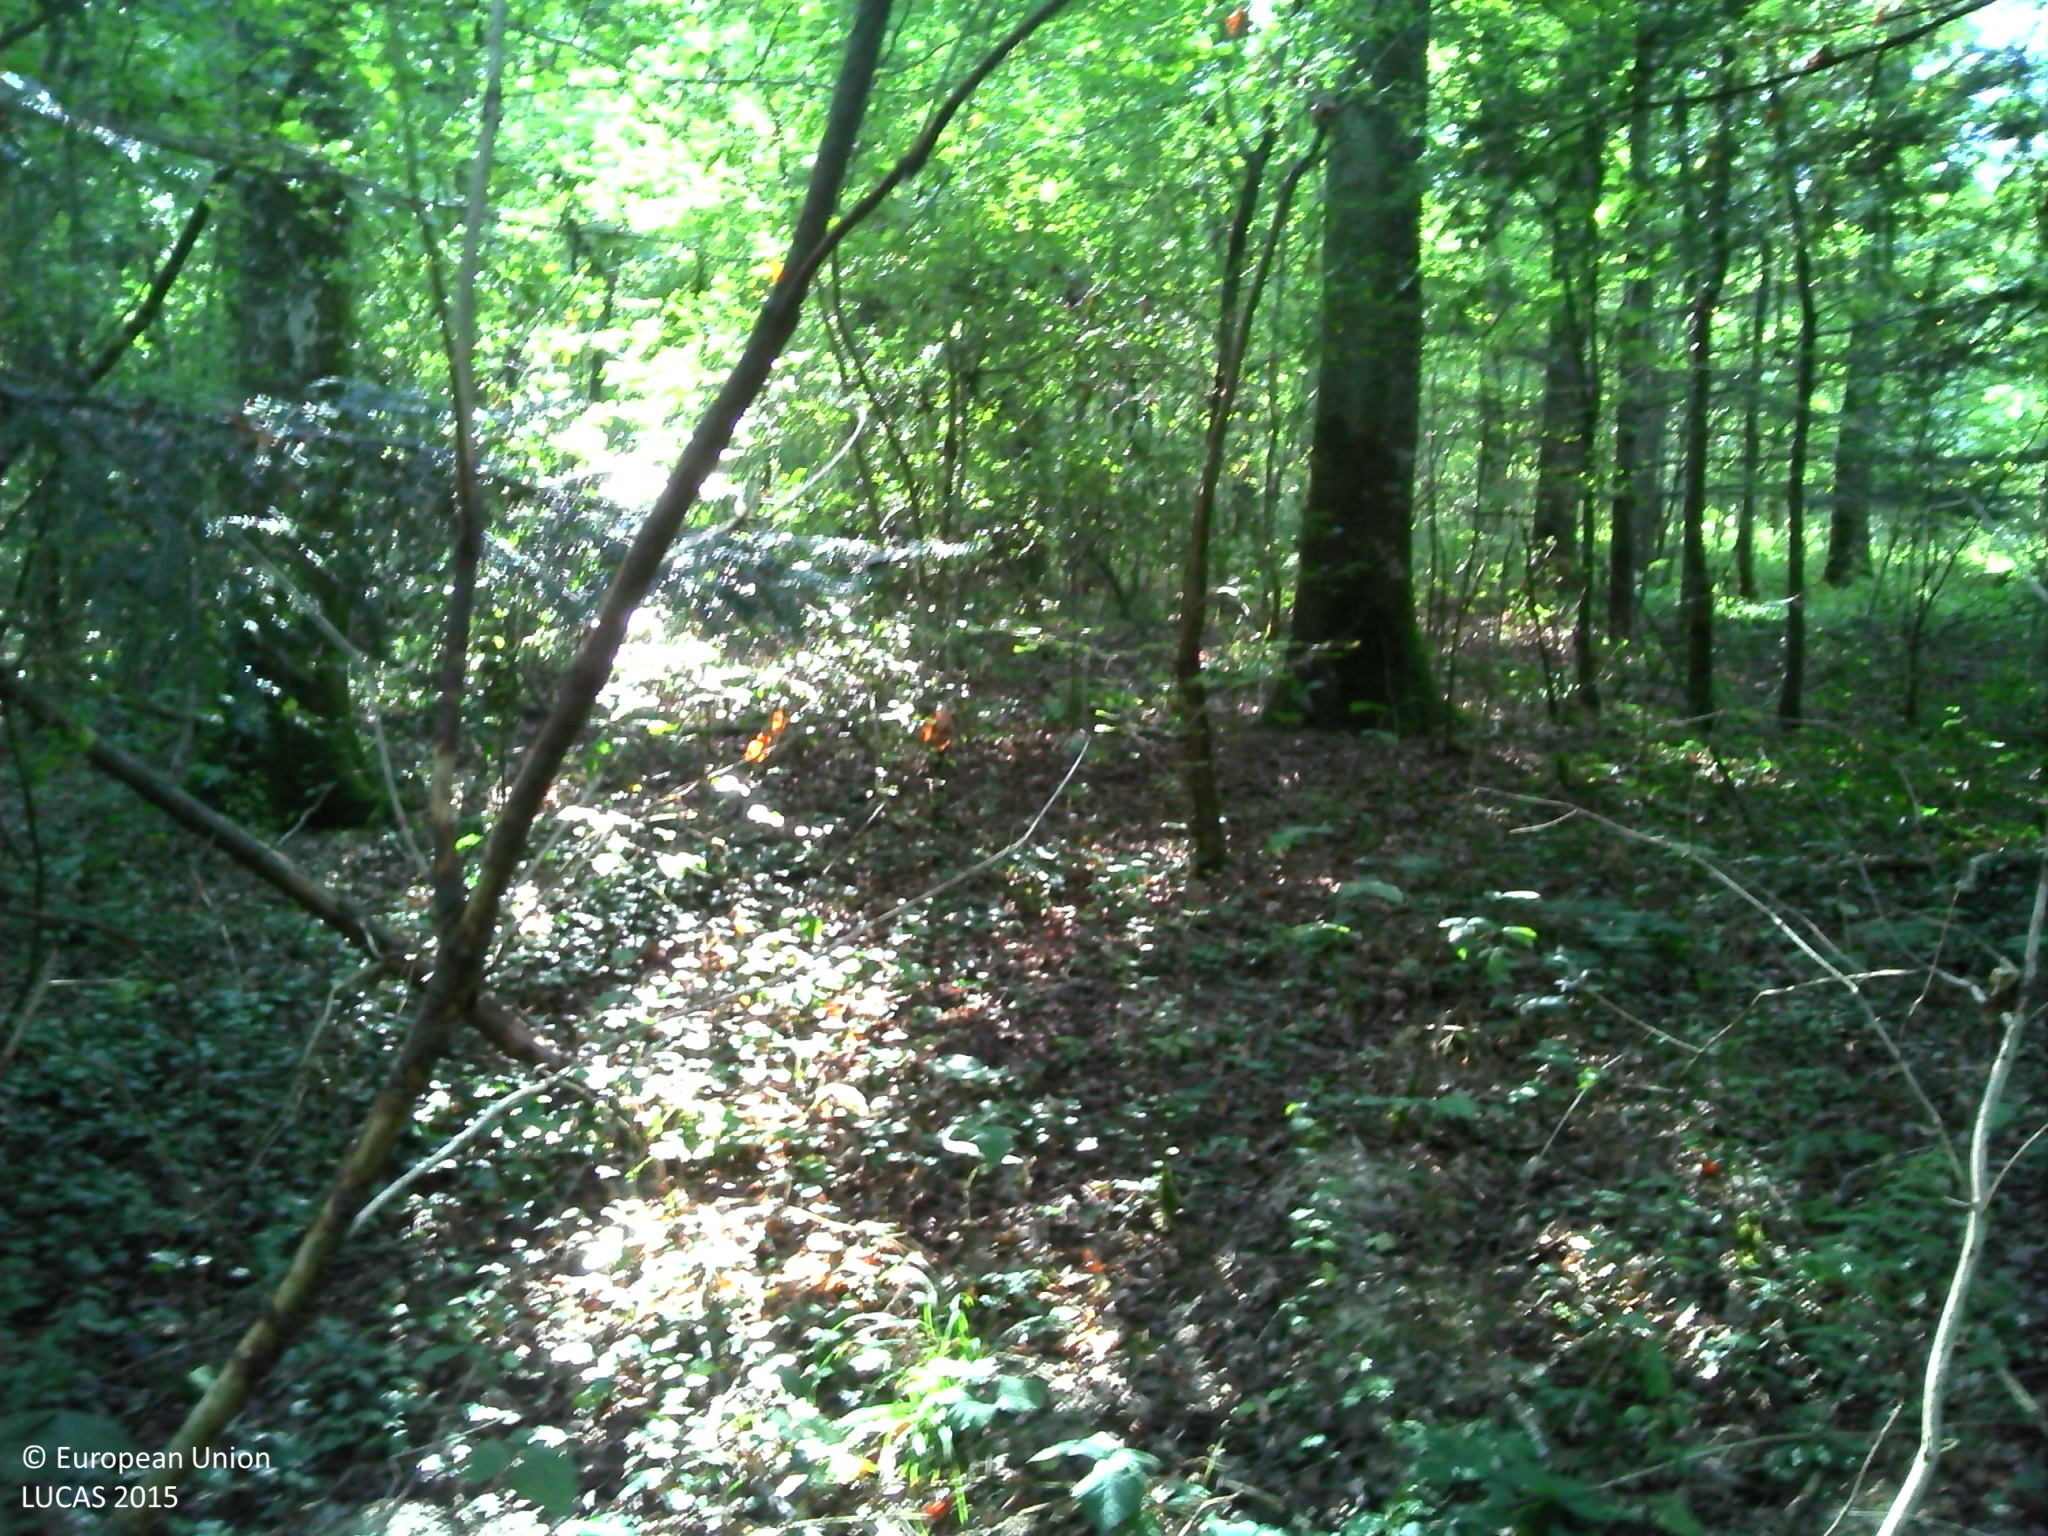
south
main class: Woodland
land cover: Spruce dominated mixed woodland
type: mesophytic deciduous forest
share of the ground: > 75 %
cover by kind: broadleaved forest trees 70 %, coniferous forest trees 30 %
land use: Forestry
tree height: > 5 m
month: October
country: FR
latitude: 48.1819
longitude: 4.2540
